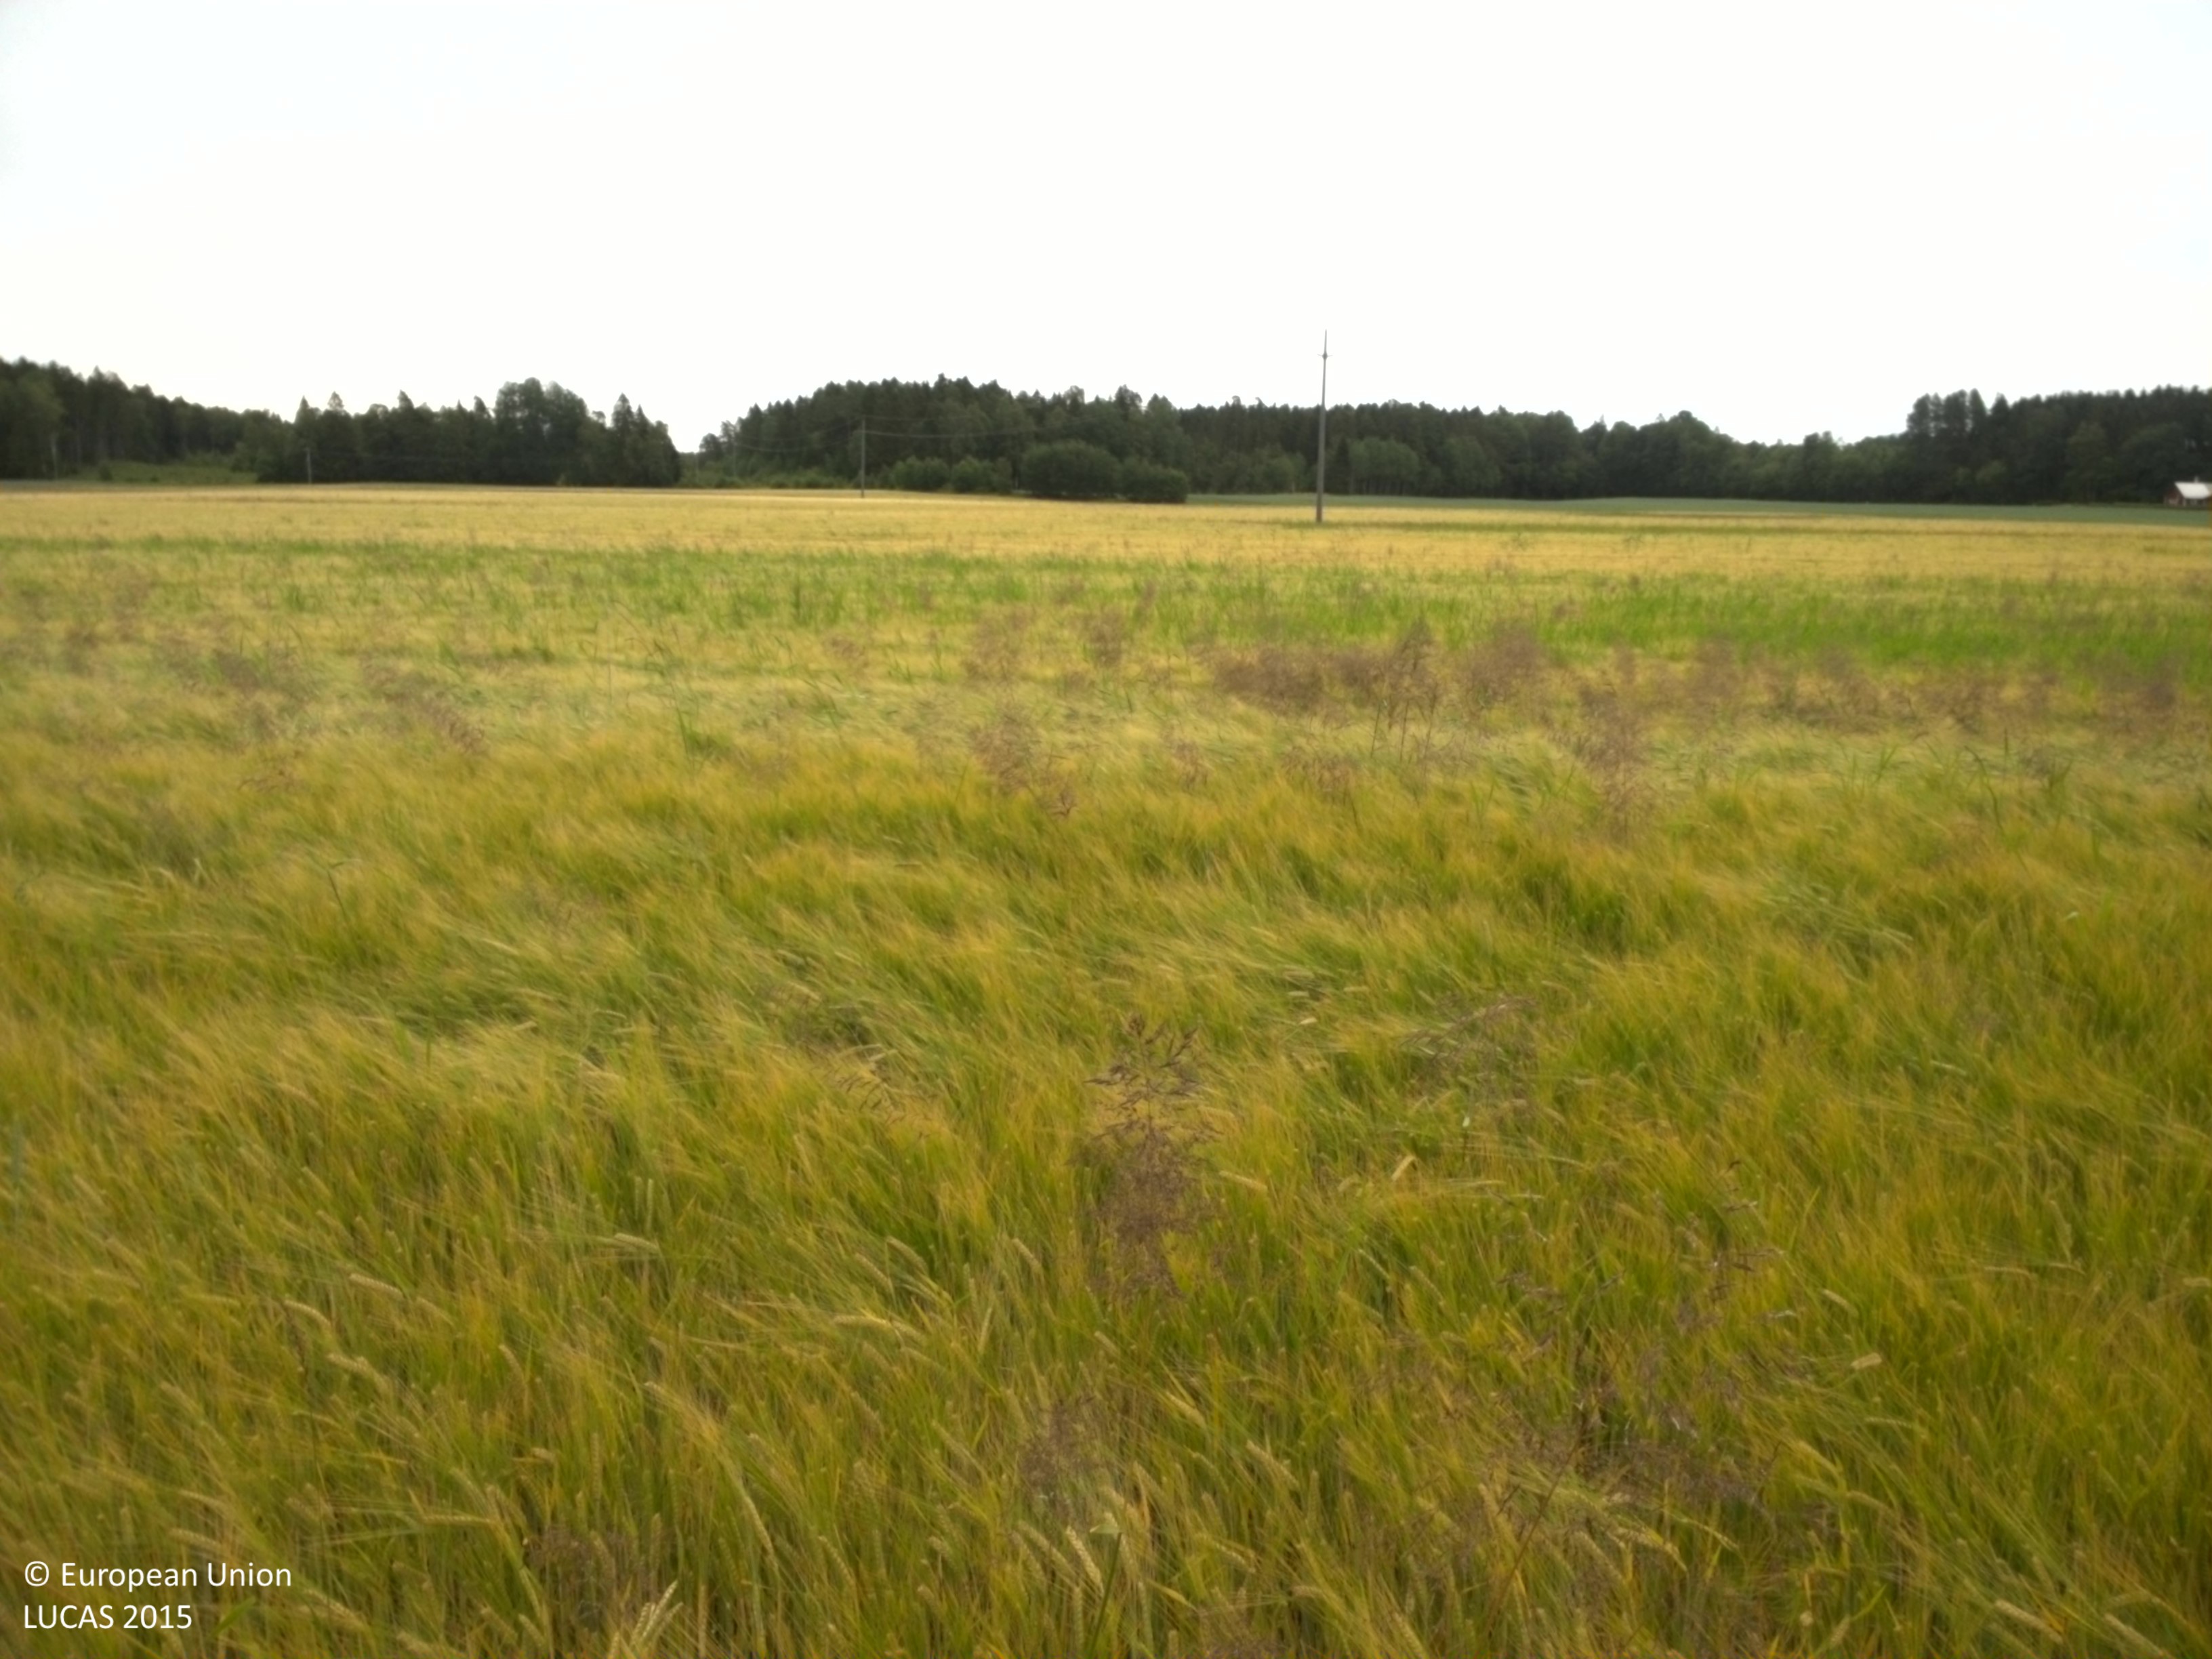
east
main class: Cropland
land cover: Barley
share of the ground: > 75 %
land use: Agriculture (excluding fallow land and kitchen gardens)
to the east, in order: Barley; Electric lines; Barley
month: July
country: SE
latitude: 58.3764
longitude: 13.3285
